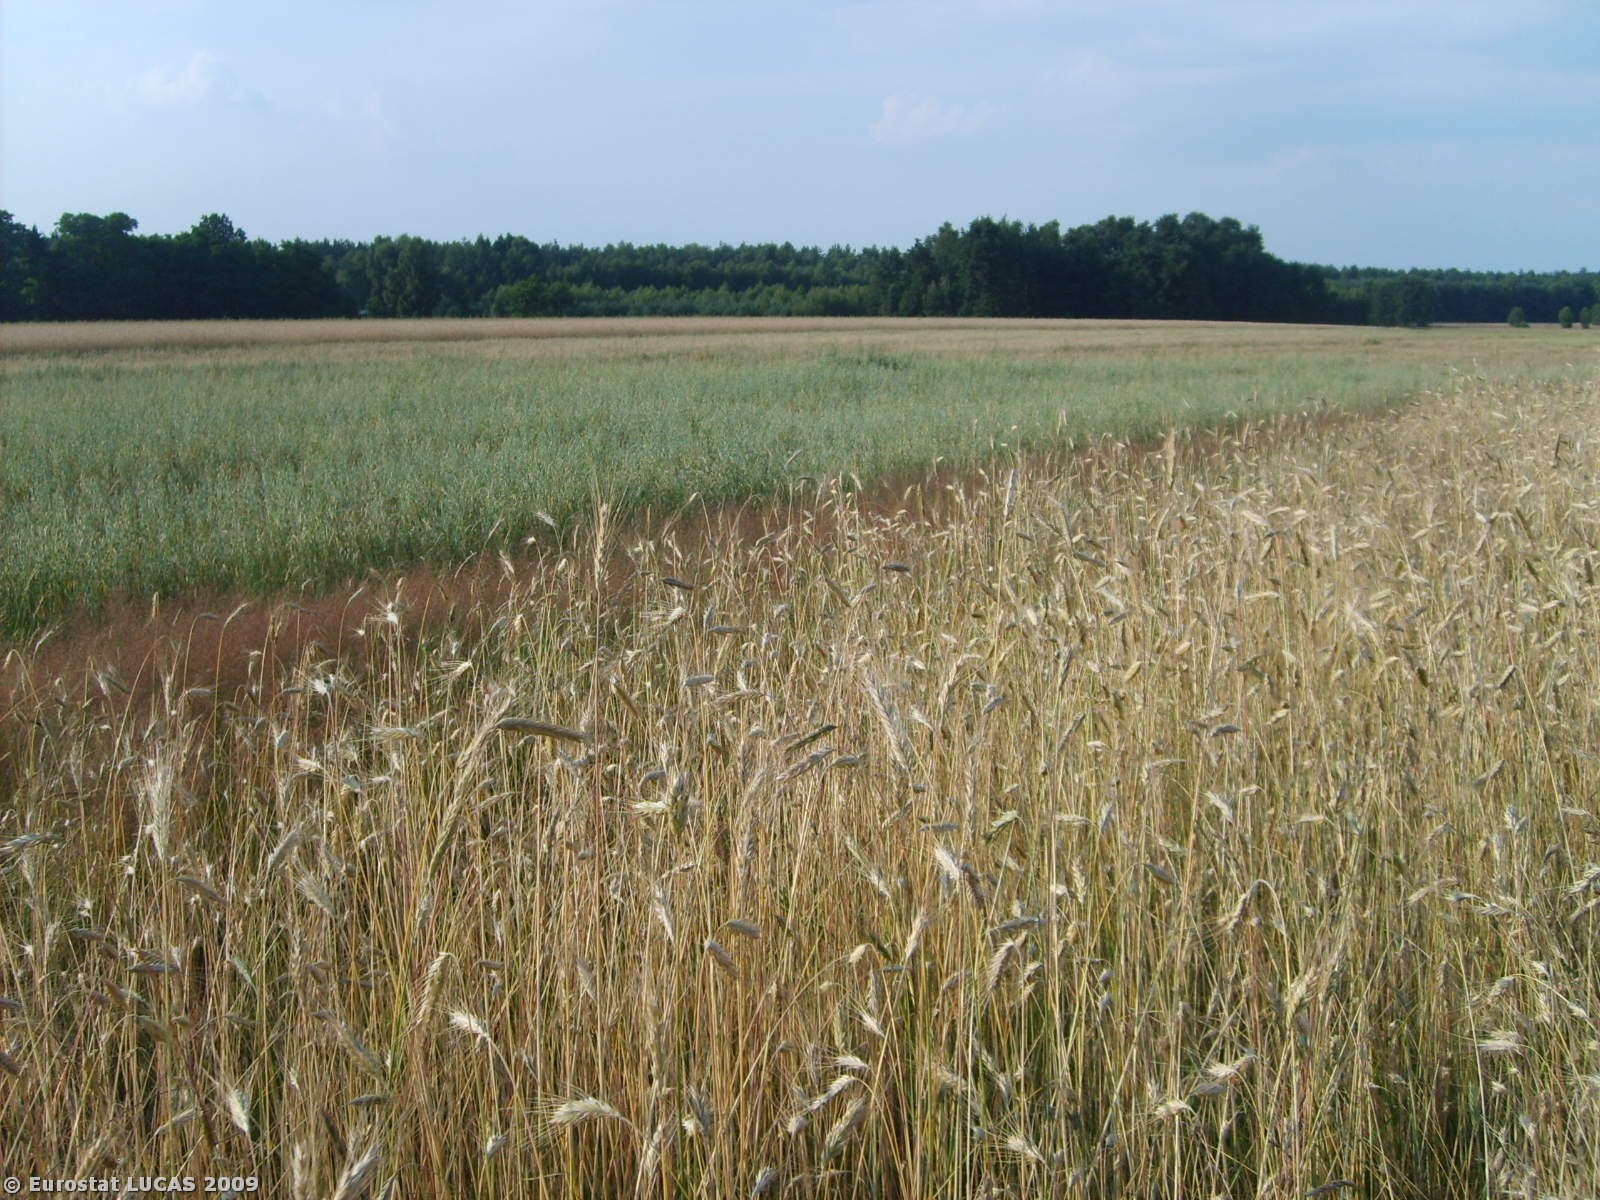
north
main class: Cropland
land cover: Rye
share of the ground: > 75 %
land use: Agriculture (excluding fallow land and kitchen gardens)
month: July
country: PL
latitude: 52.4132
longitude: 21.7126
